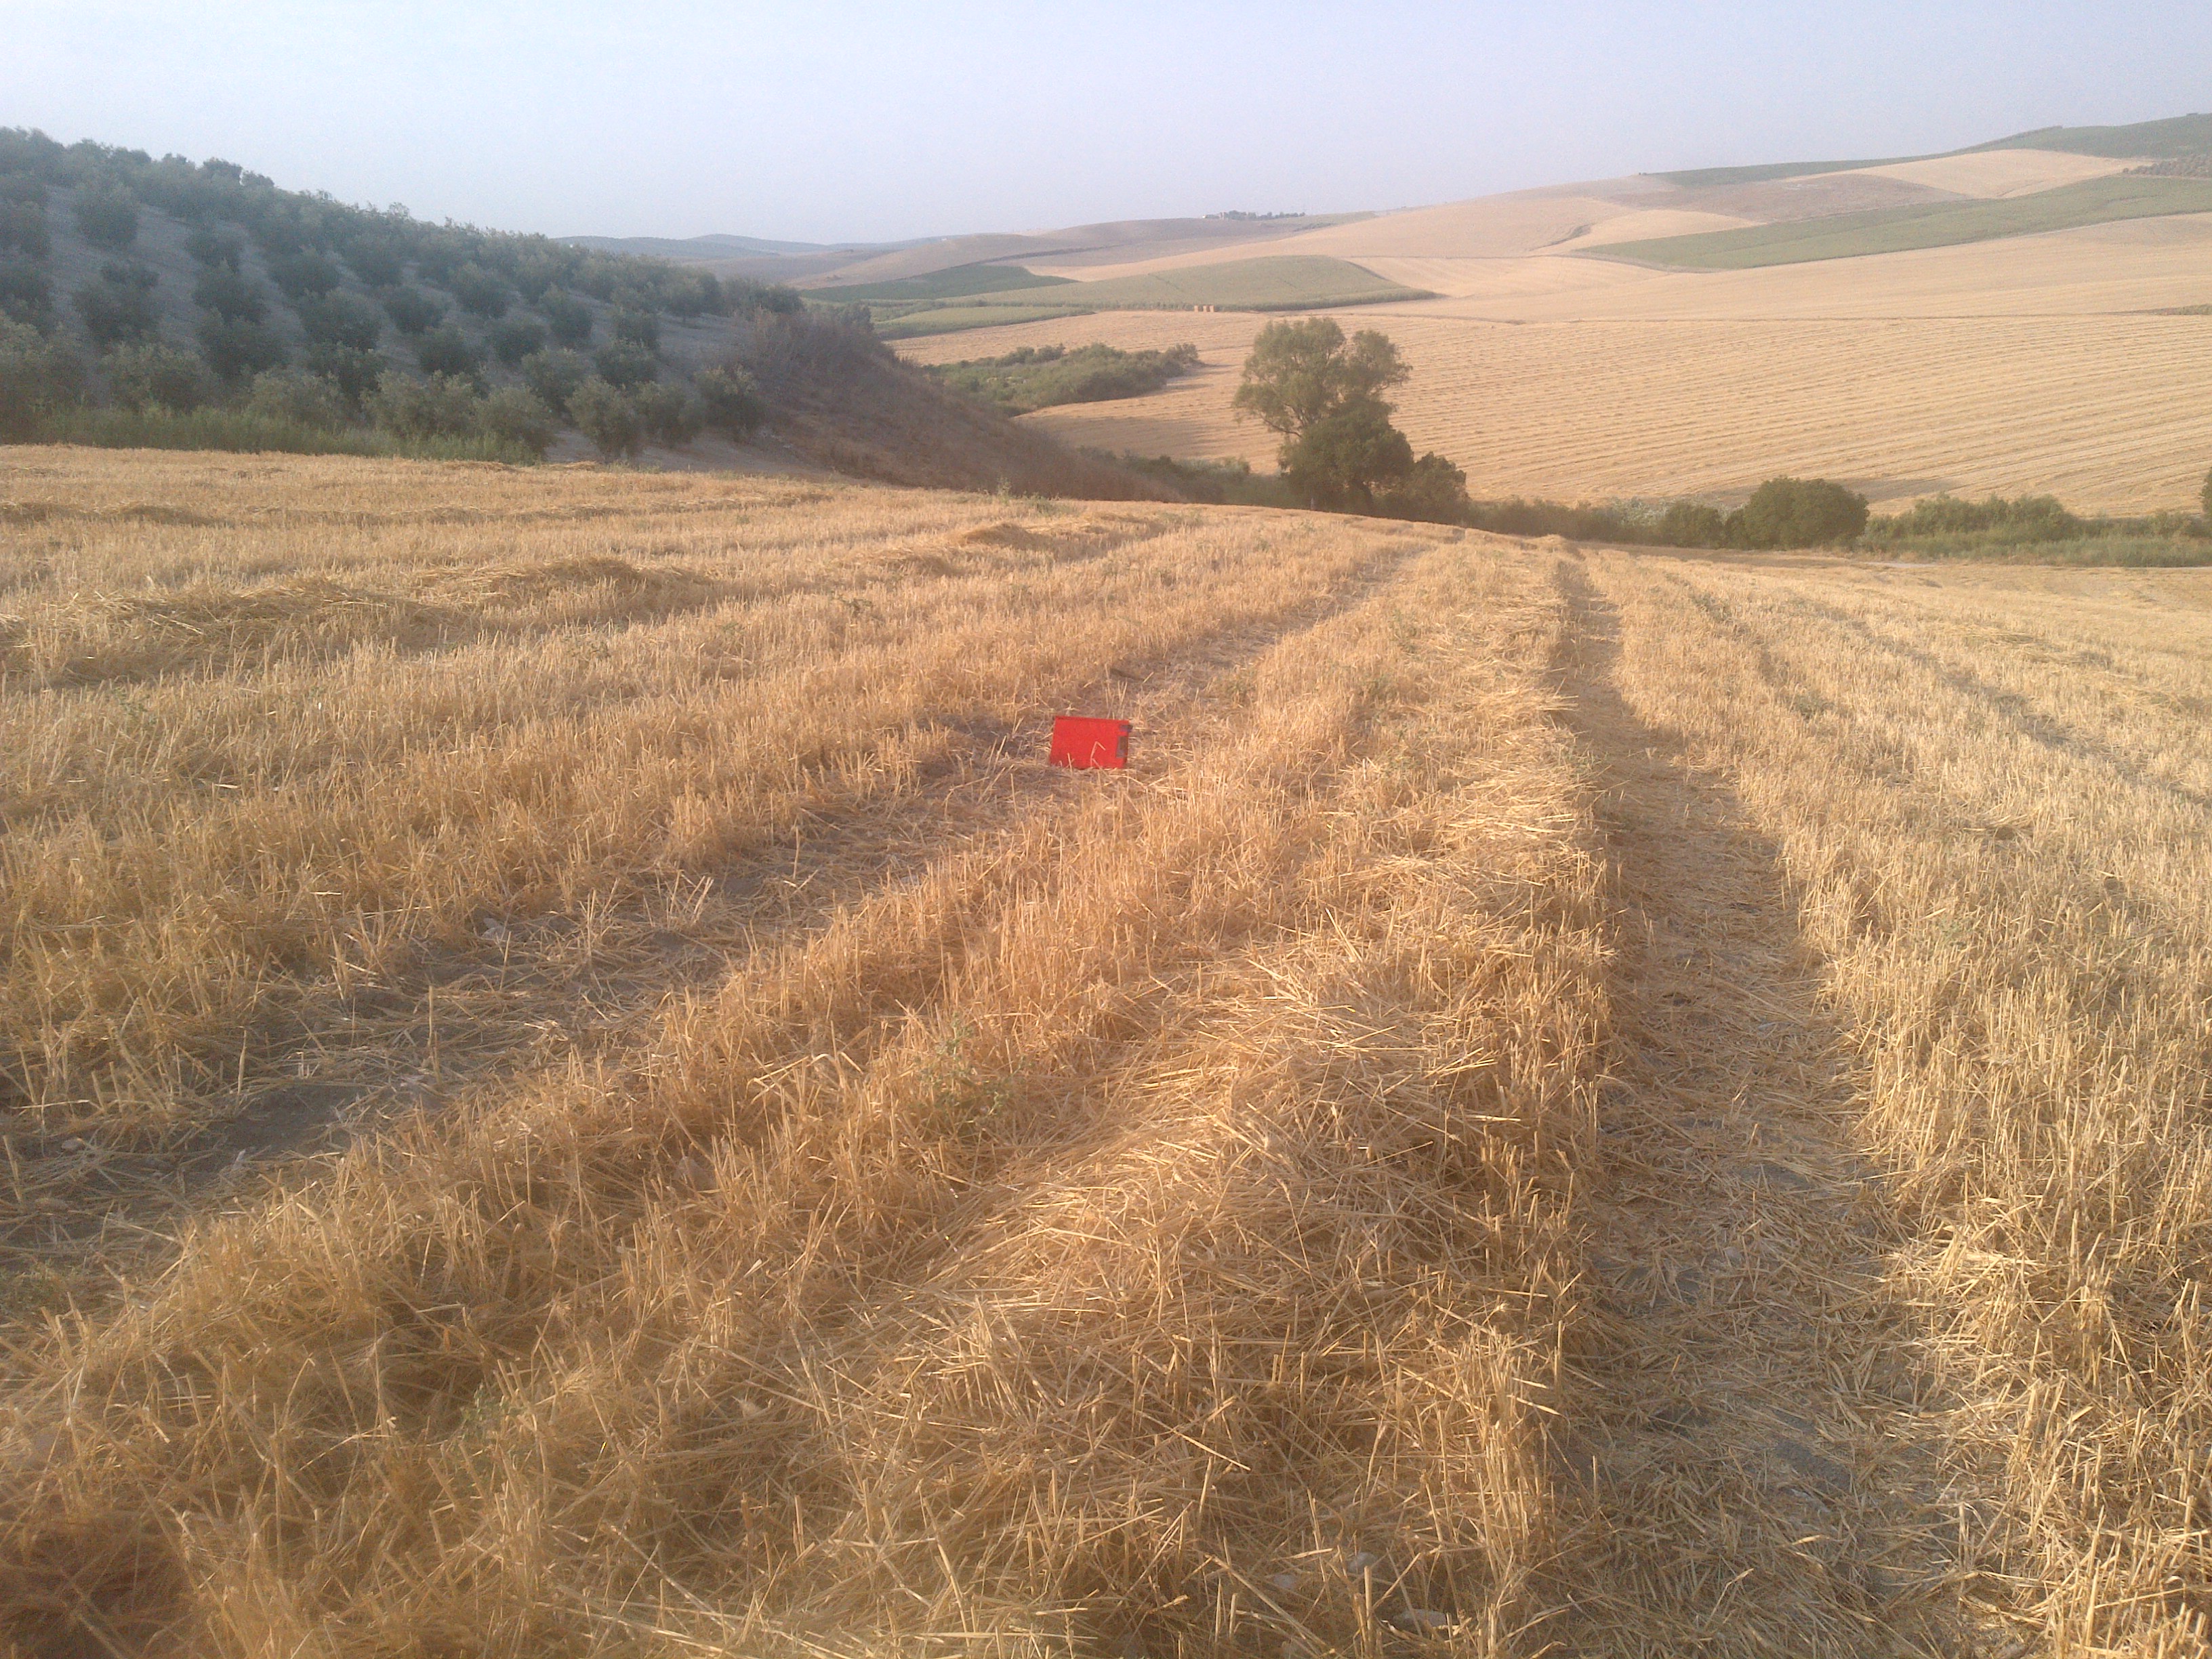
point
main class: Cropland
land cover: Durum wheat
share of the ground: < 10 %
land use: Agriculture (excluding fallow land and kitchen gardens)
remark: Harvested field
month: July
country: ES
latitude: 37.4787
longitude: -4.8334
